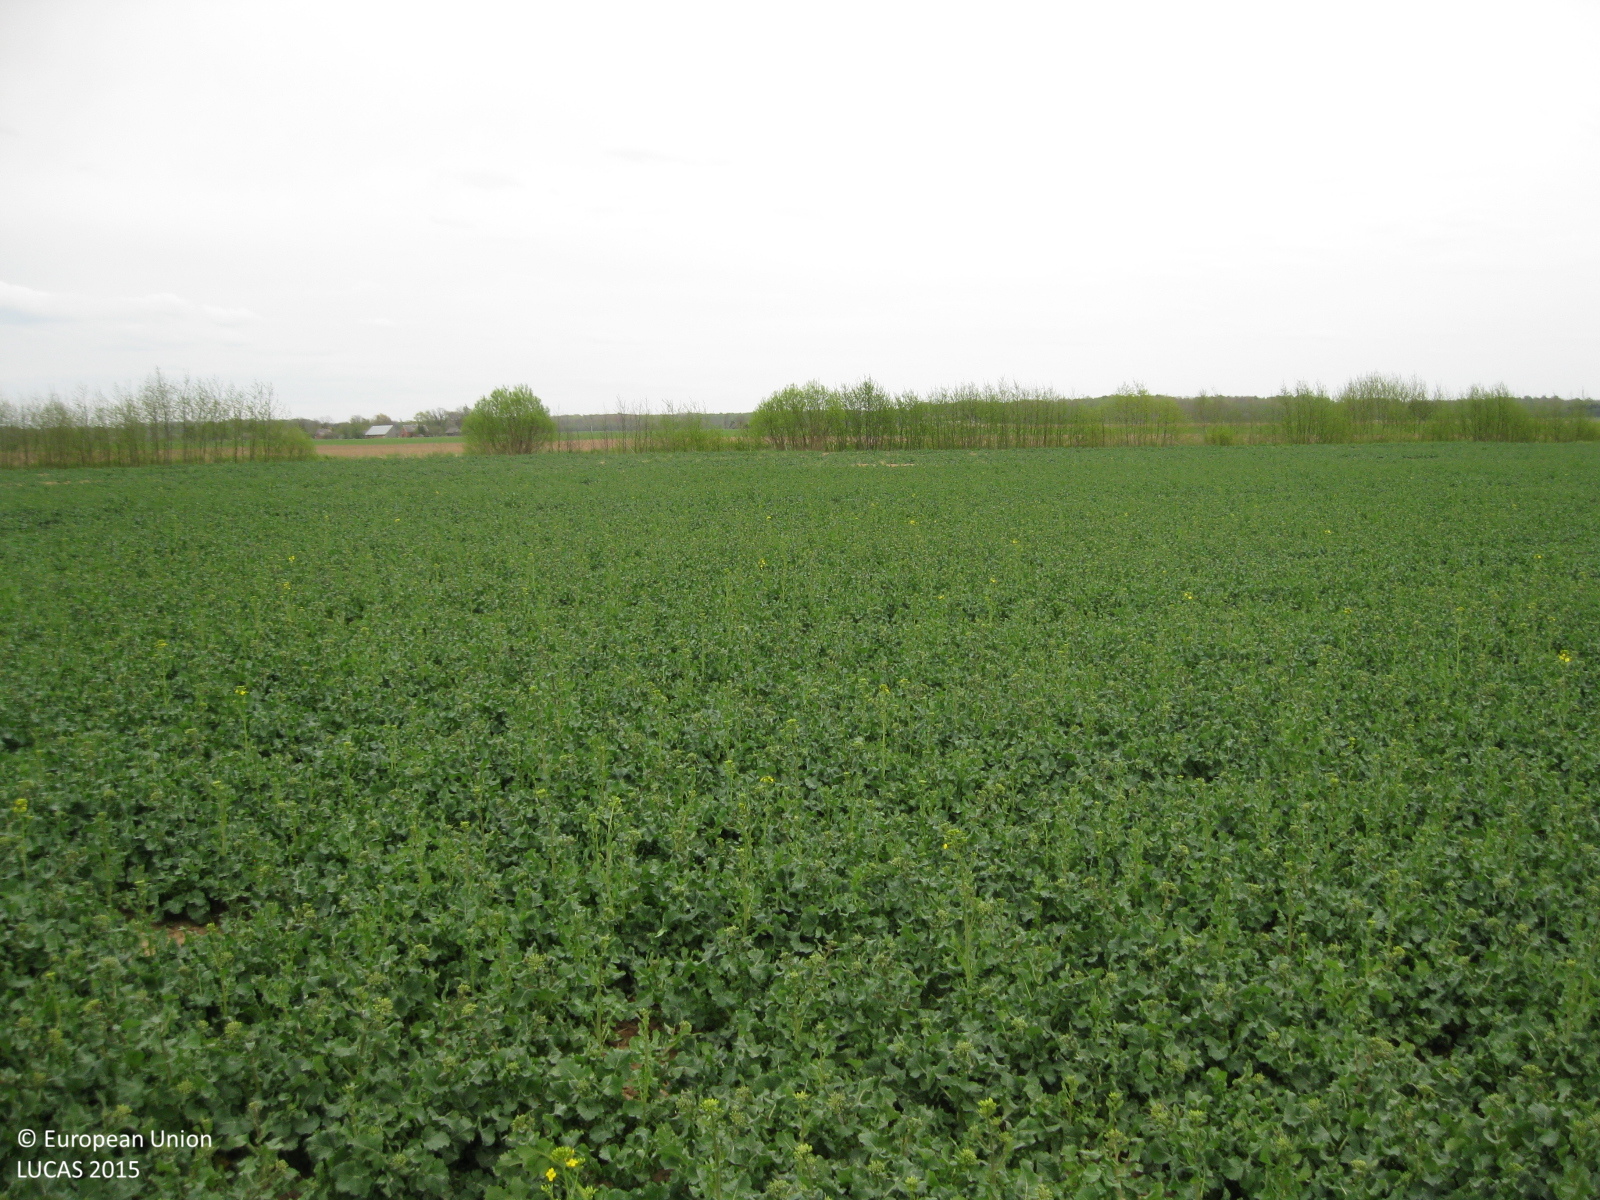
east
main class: Cropland
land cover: Rape and turnip rape
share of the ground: > 75 %
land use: Agriculture (excluding fallow land and kitchen gardens)
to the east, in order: Rape and turnip rape; Grass margins; Abandoned hedges; Ditches and canals; Grassland with sparse tree/shrub cover; Other bare soil
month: May
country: LT
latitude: 56.2010
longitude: 24.4910
